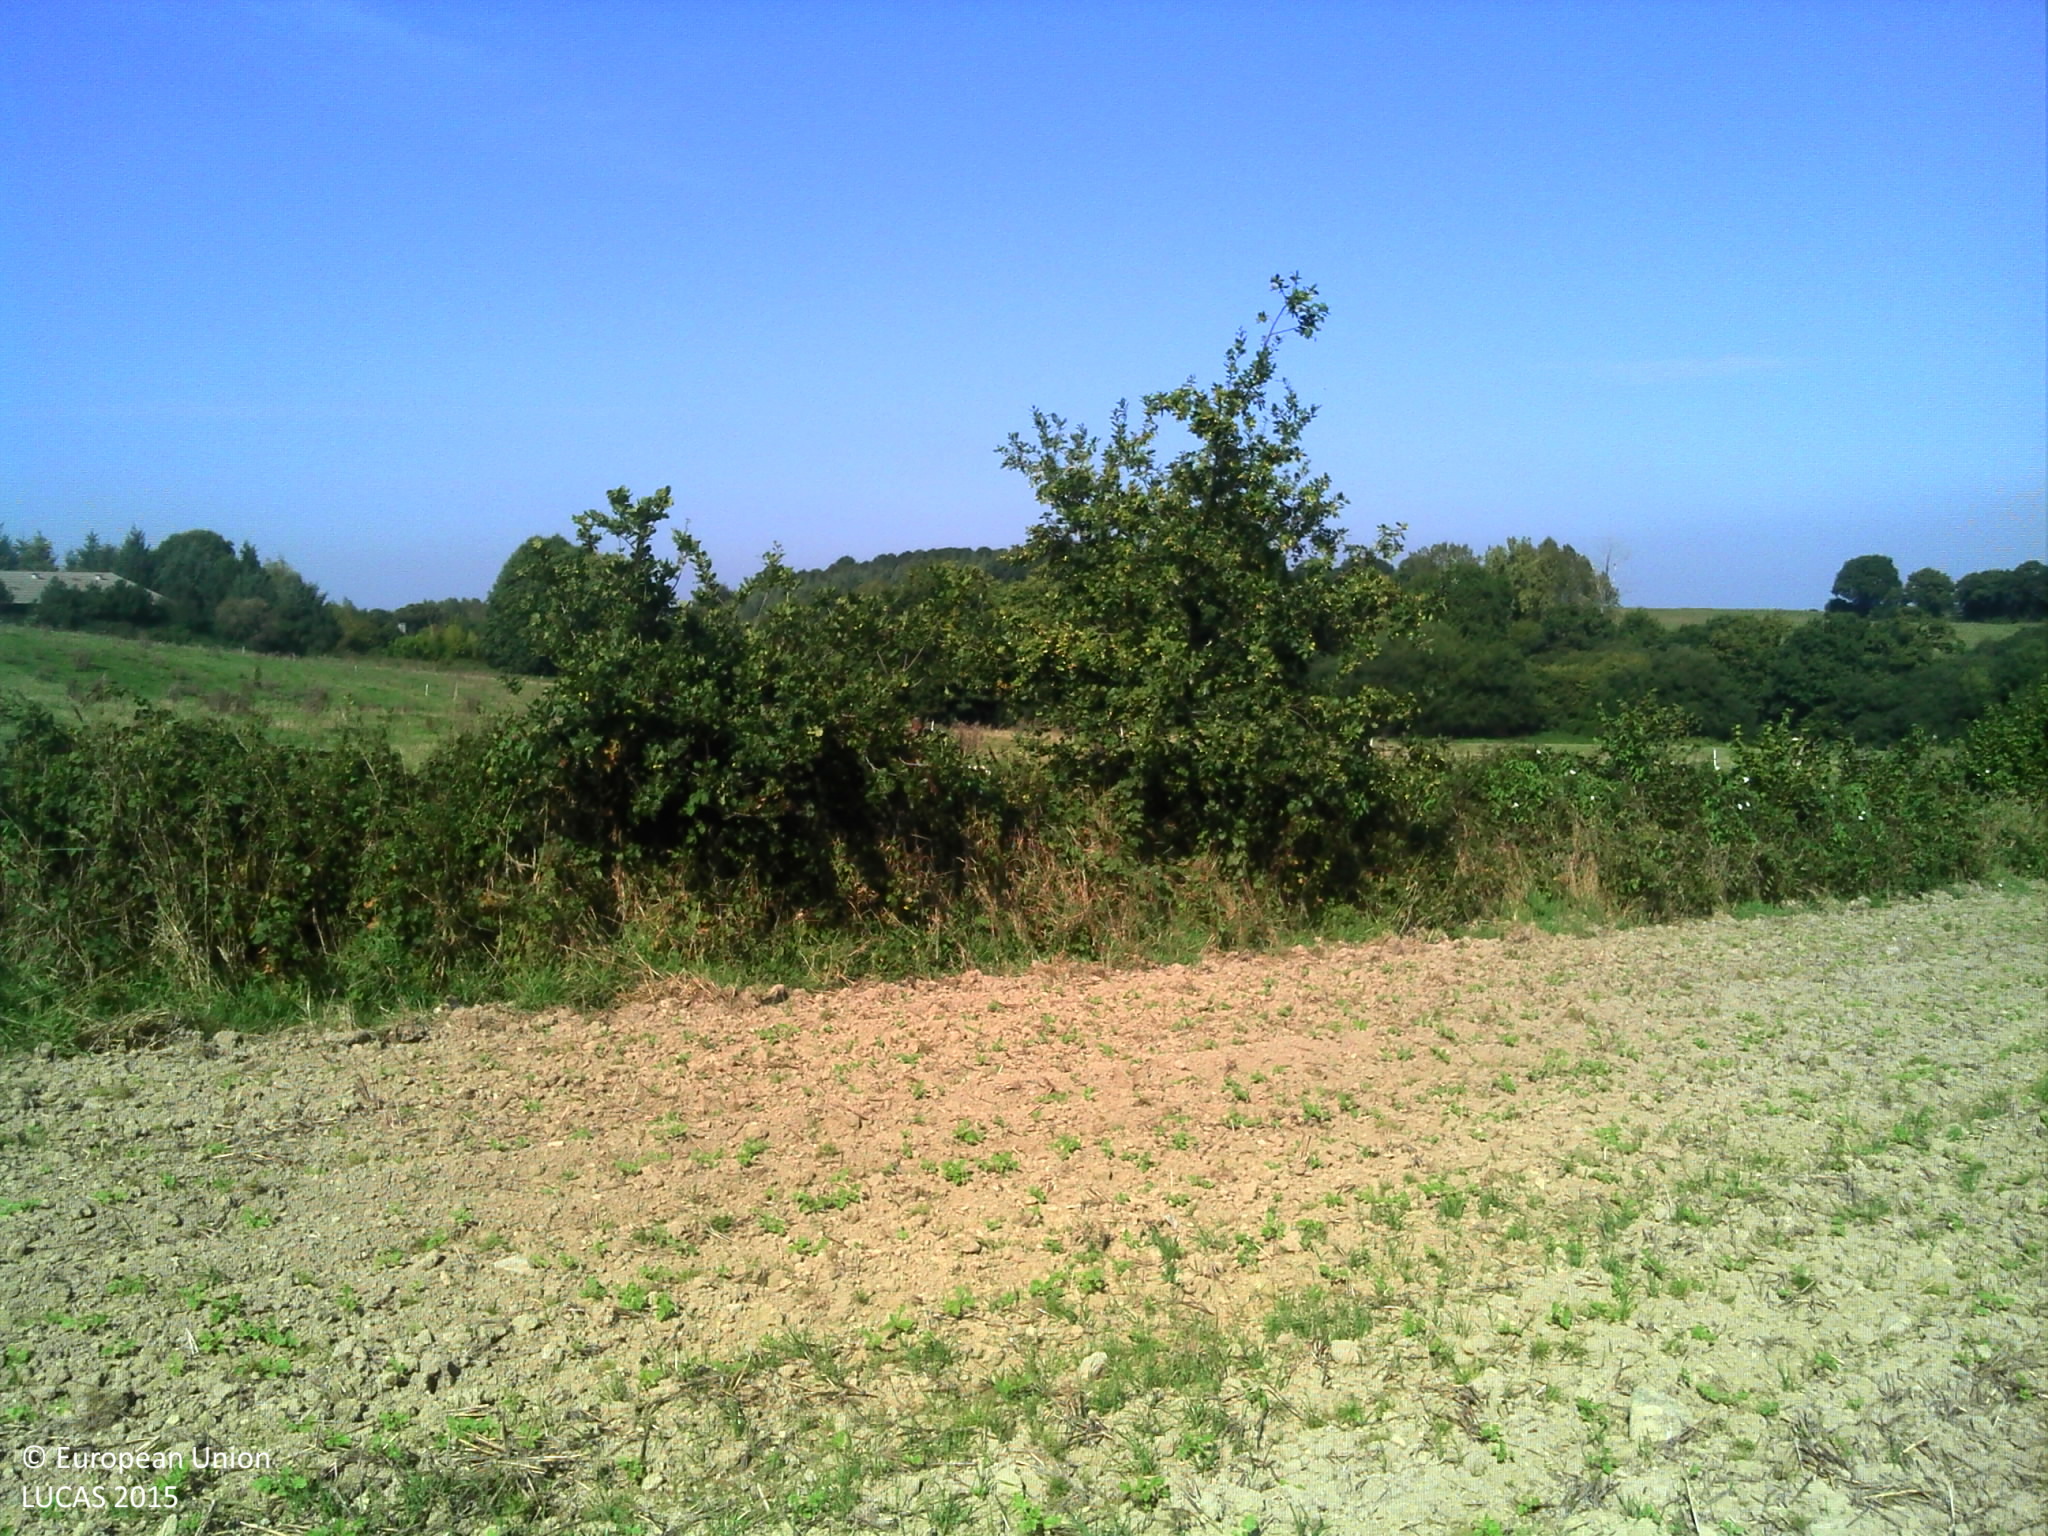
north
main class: Cropland
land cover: Rape and turnip rape
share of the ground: 10 - 25 %
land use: Agriculture (excluding fallow land and kitchen gardens)
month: October
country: FR
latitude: 48.4560
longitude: -3.1206
